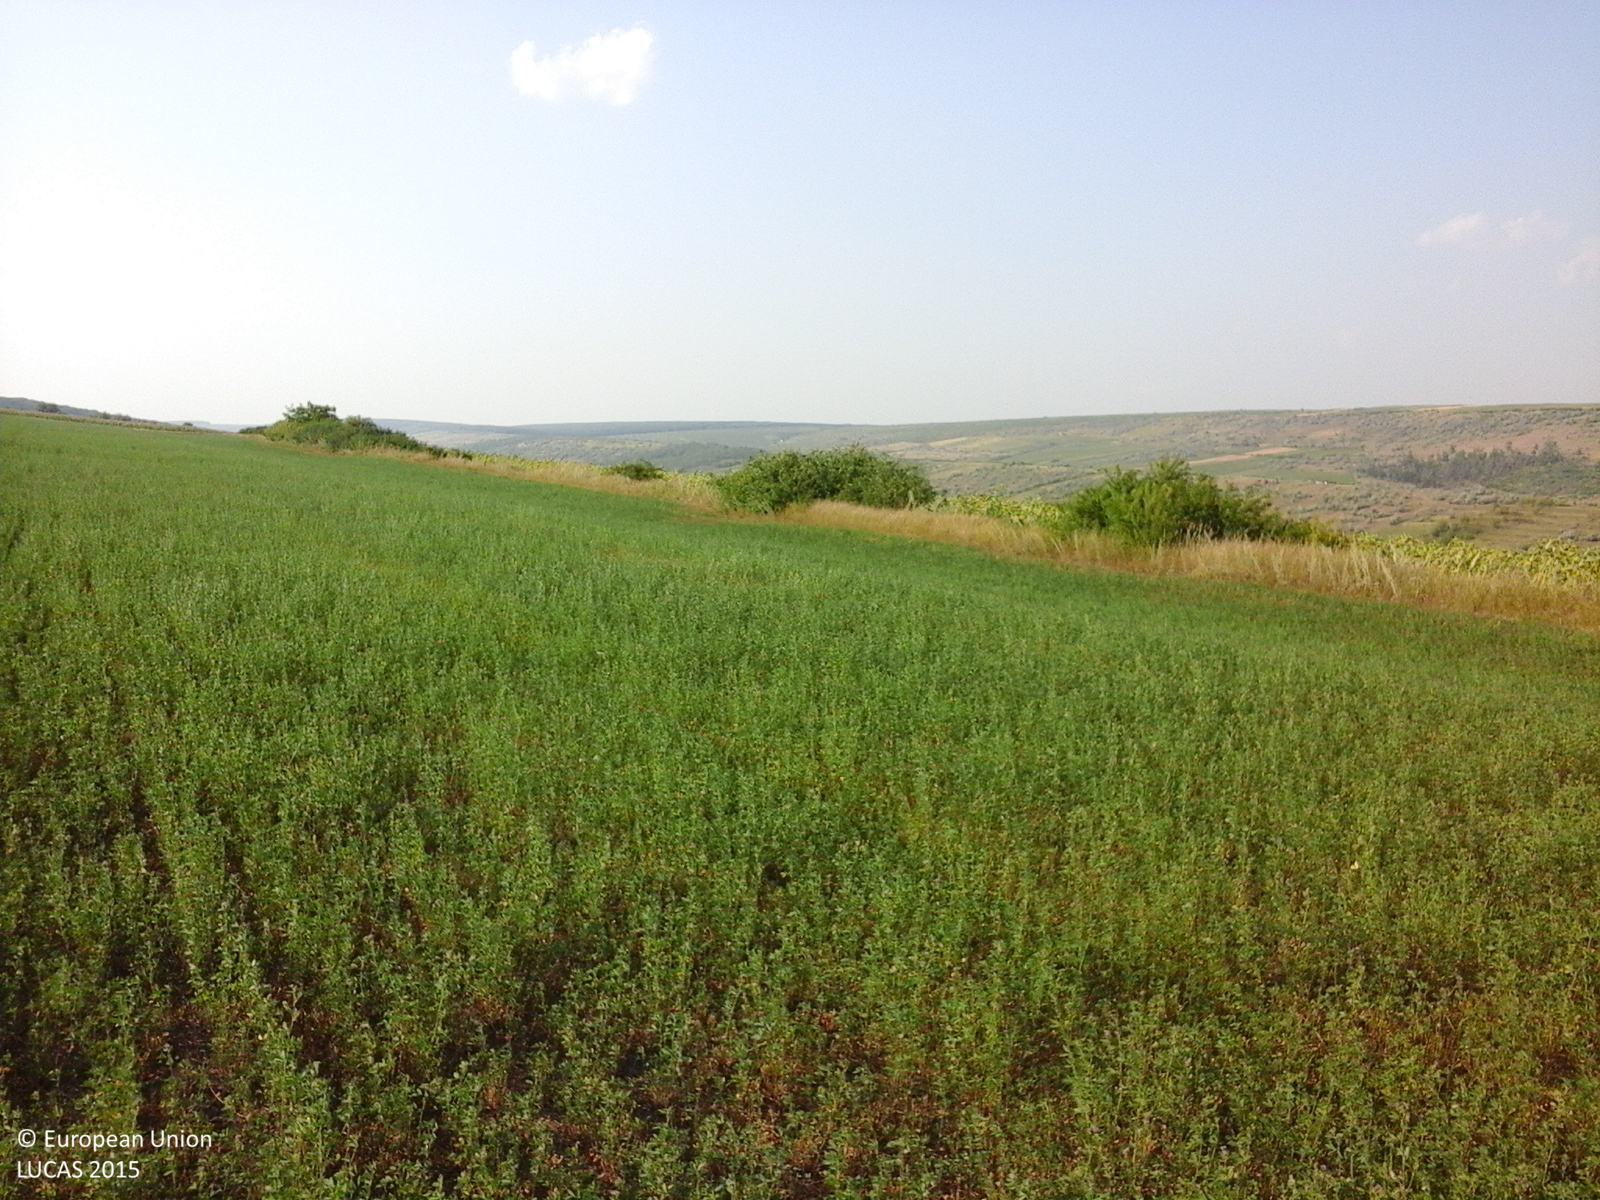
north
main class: Cropland
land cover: Lucerne
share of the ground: > 75 %
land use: Agriculture (excluding fallow land and kitchen gardens)
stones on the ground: < 10 %
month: July
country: RO
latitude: 46.3086
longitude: 27.6296
